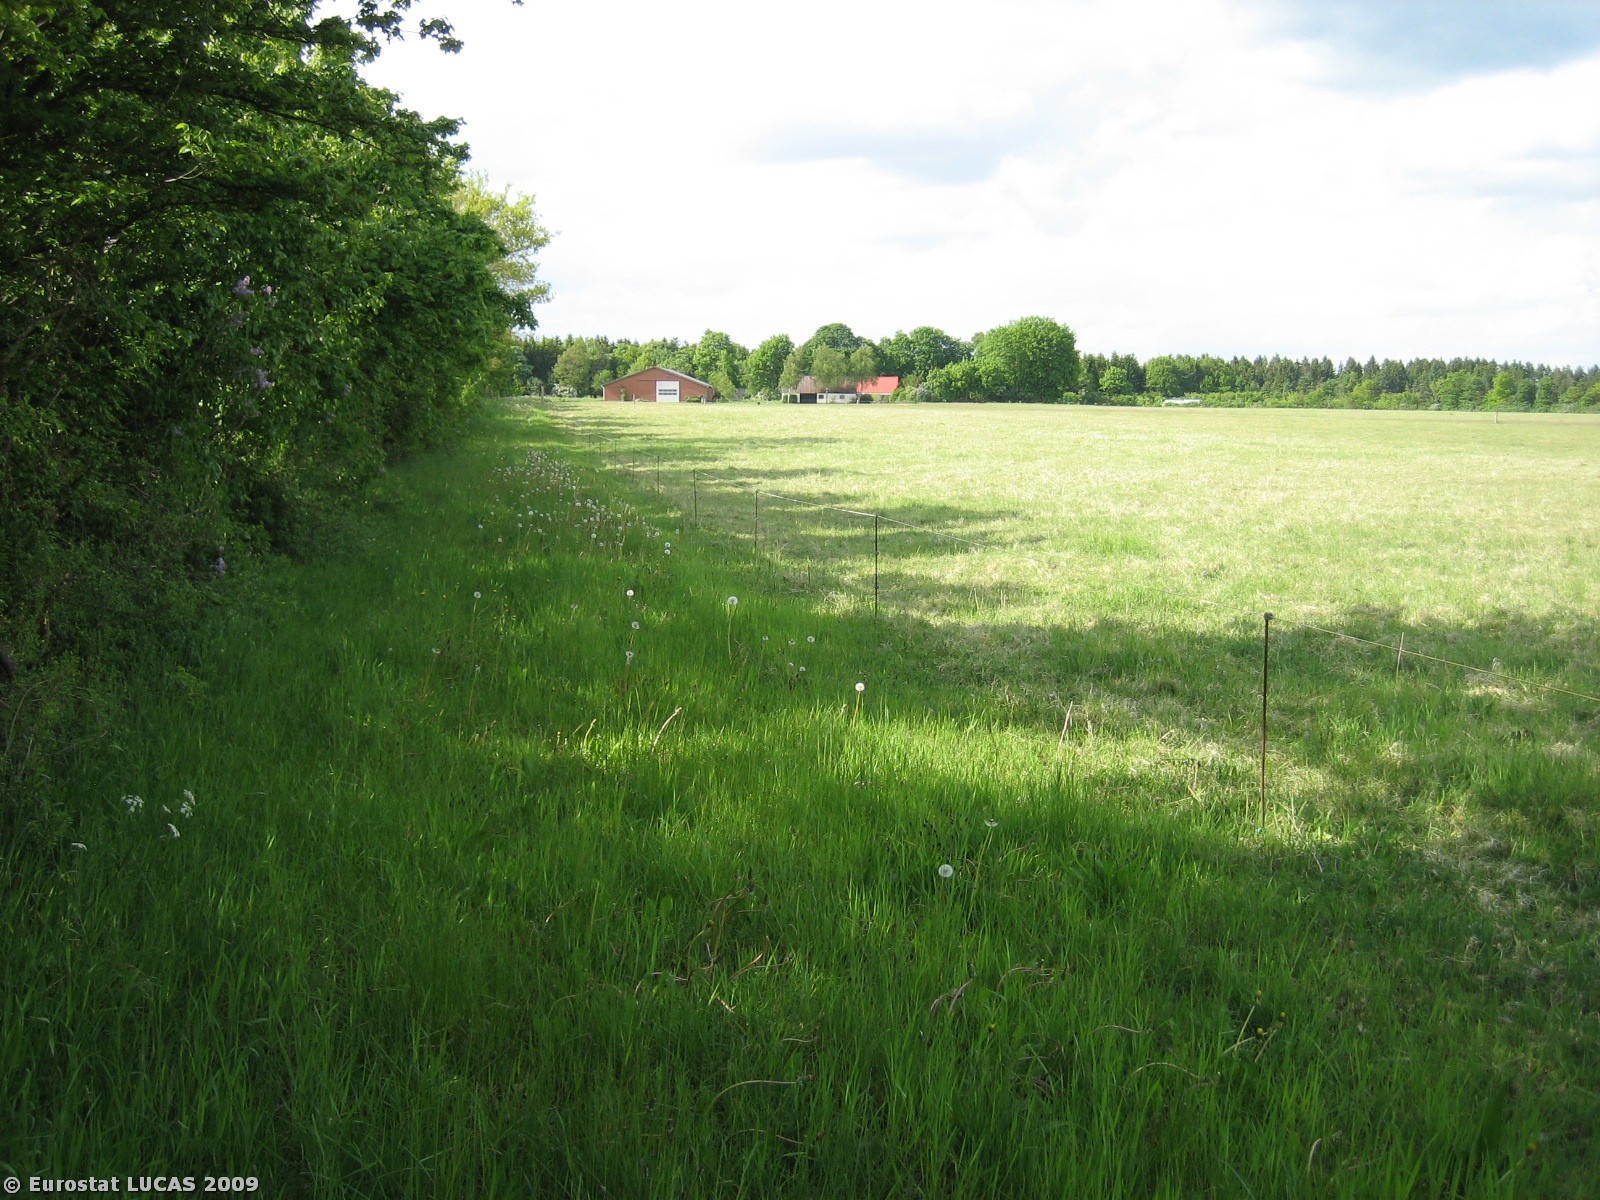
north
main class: Grassland
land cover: Grassland without tree/shrub cover
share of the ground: > 75 %
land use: Agriculture (excluding fallow land and kitchen gardens)
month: May
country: DK
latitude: 56.1859
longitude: 9.3080
